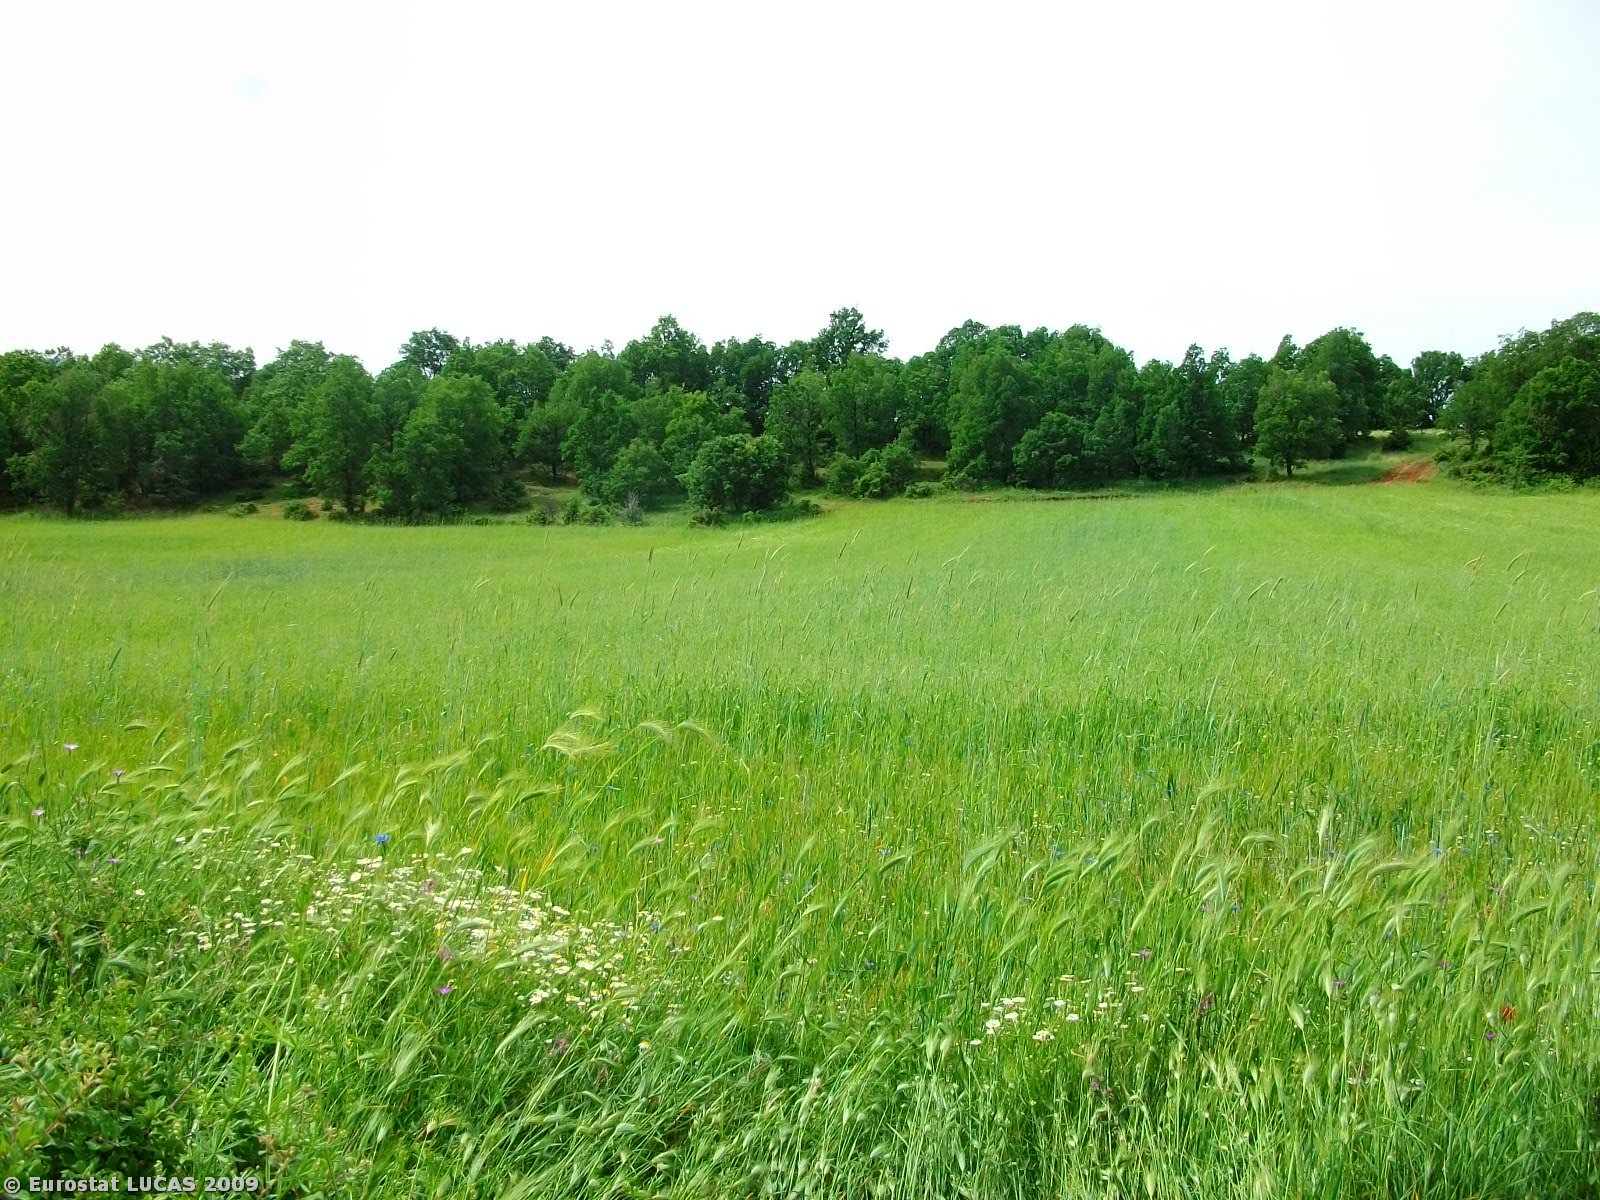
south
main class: Cropland
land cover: Barley
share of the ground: > 75 %
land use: Agriculture (excluding fallow land and kitchen gardens)
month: May
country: GR
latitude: 40.7128
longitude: 21.8697
